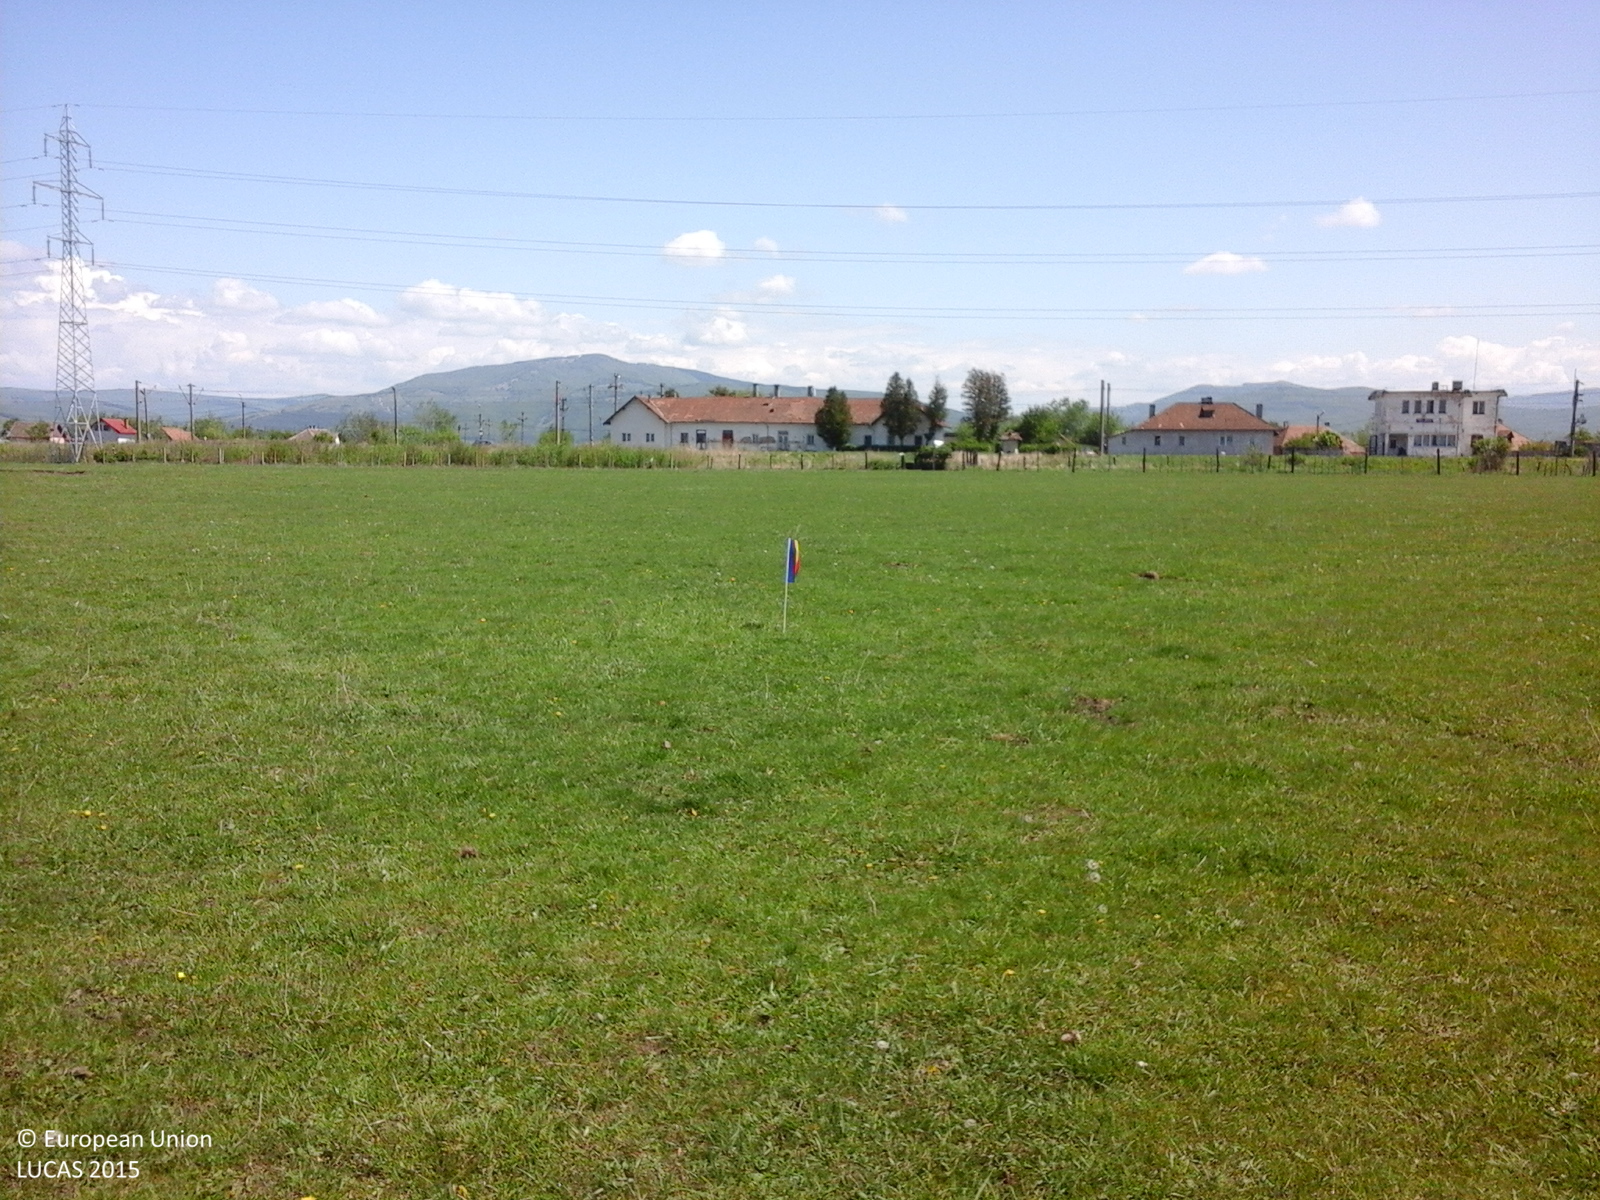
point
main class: Grassland
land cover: Grassland without tree/shrub cover
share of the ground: > 75 %
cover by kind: herbaceous plants 100 %
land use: Agriculture (excluding fallow land and kitchen gardens)
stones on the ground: < 10 %
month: May
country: RO
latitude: 45.7396
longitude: 25.7763
